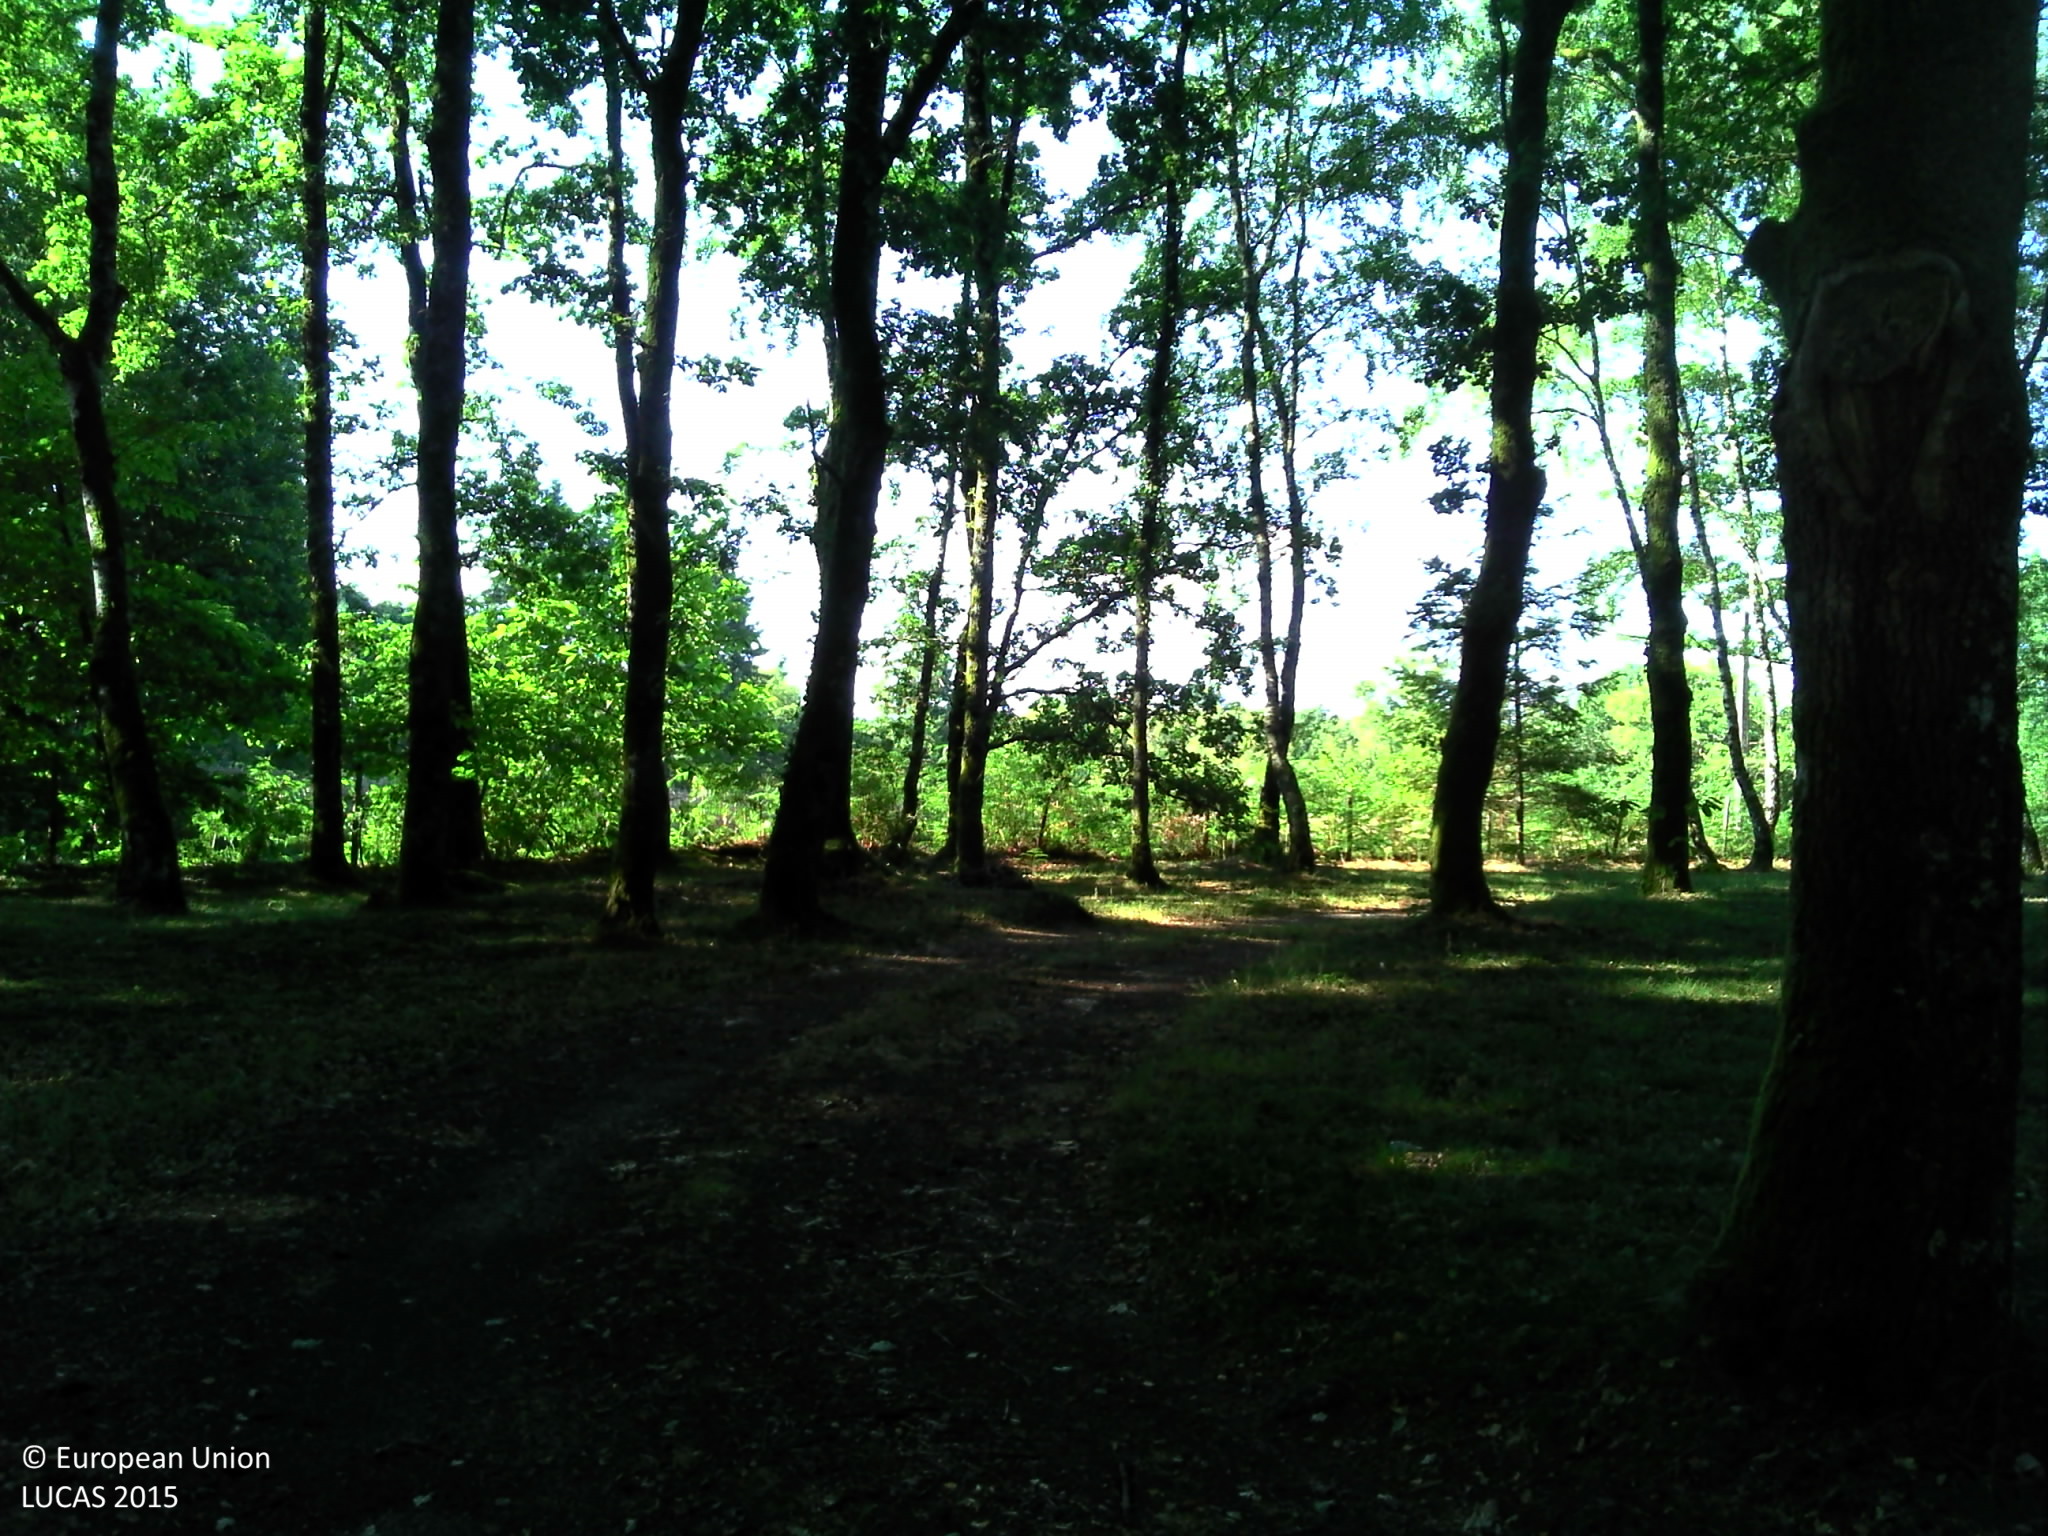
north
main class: Woodland
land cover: Broadleaved woodland
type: acidophilous oak and oak-birch forest
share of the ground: > 75 %
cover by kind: broadleaved forest trees 50 %, lichens and mosses 30 %, herbaceous plants 10 %, unconsolidated bare surface 10 %
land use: Residential
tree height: > 5 m
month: July
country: FR
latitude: 45.8255
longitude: 0.9915
